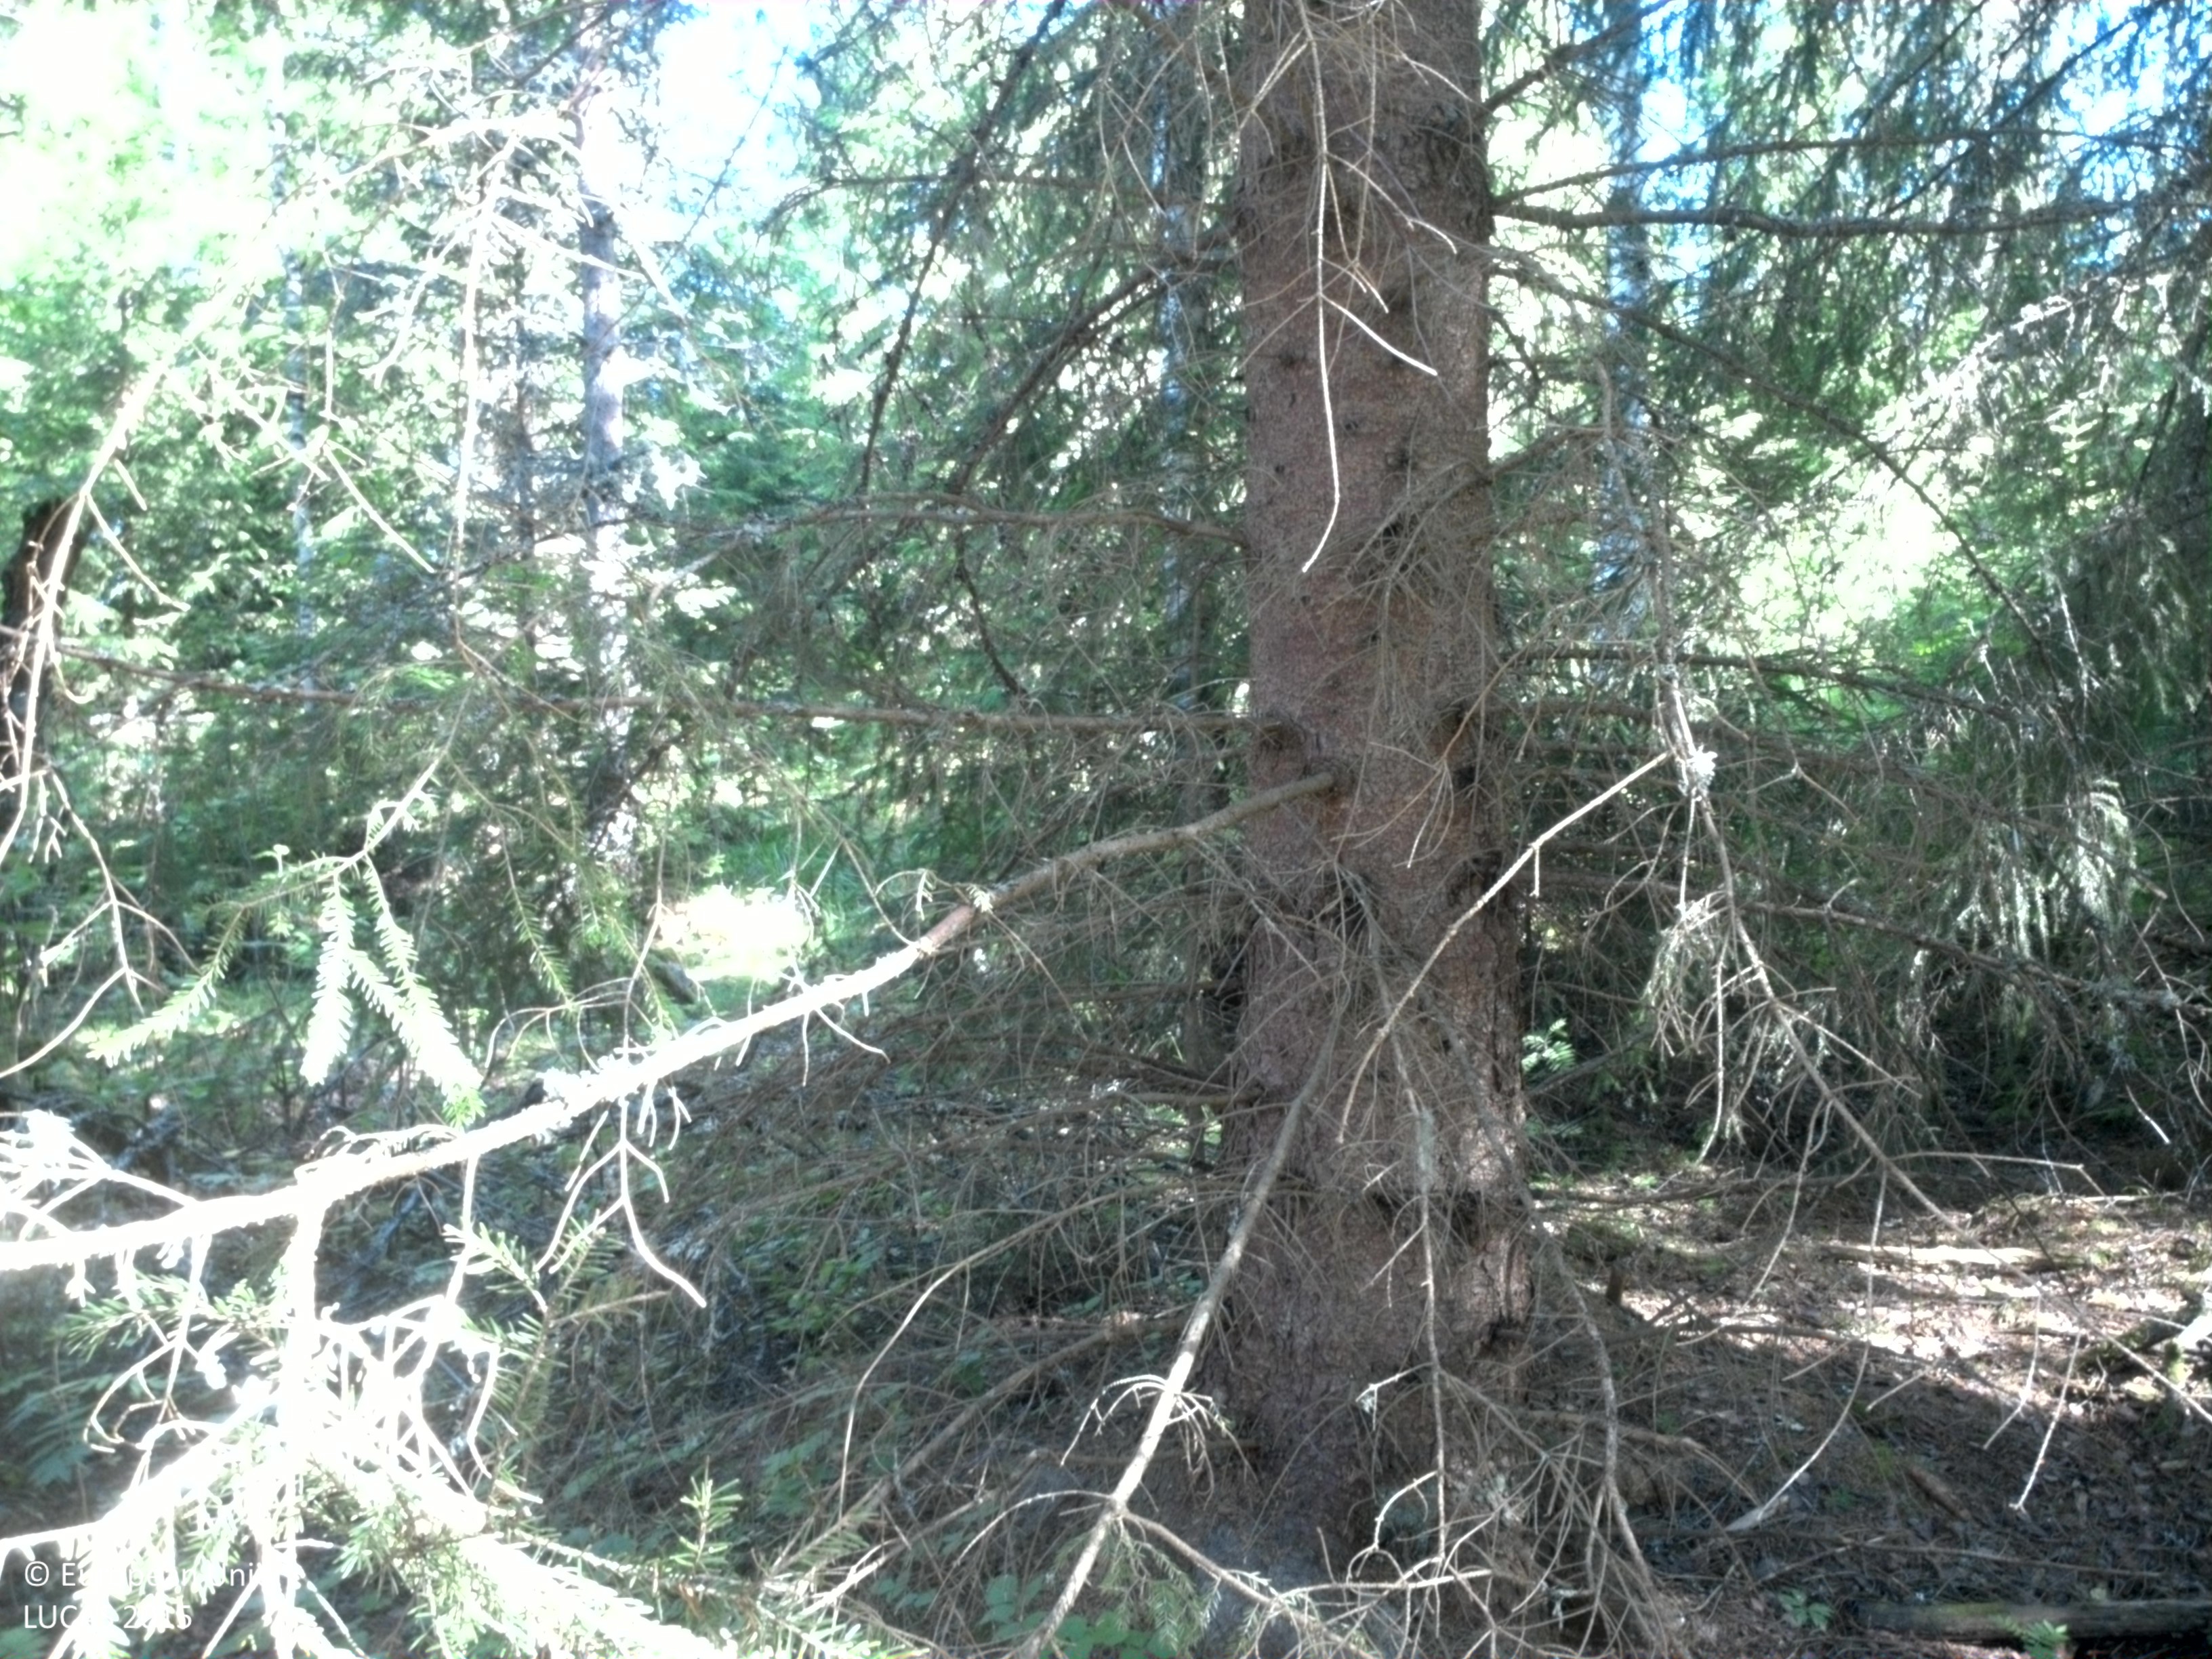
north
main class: Woodland
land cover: Spruce dominated mixed woodland
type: boreal forest
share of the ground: 50 - 75 %
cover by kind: coniferous forest trees 45 %, herbaceous plants 20 %, broadleaved forest trees 15 %, shrubs 10 %, lichens and mosses 10 %
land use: Forestry
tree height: > 5 m
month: July
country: SE
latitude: 59.9271
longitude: 12.3371
